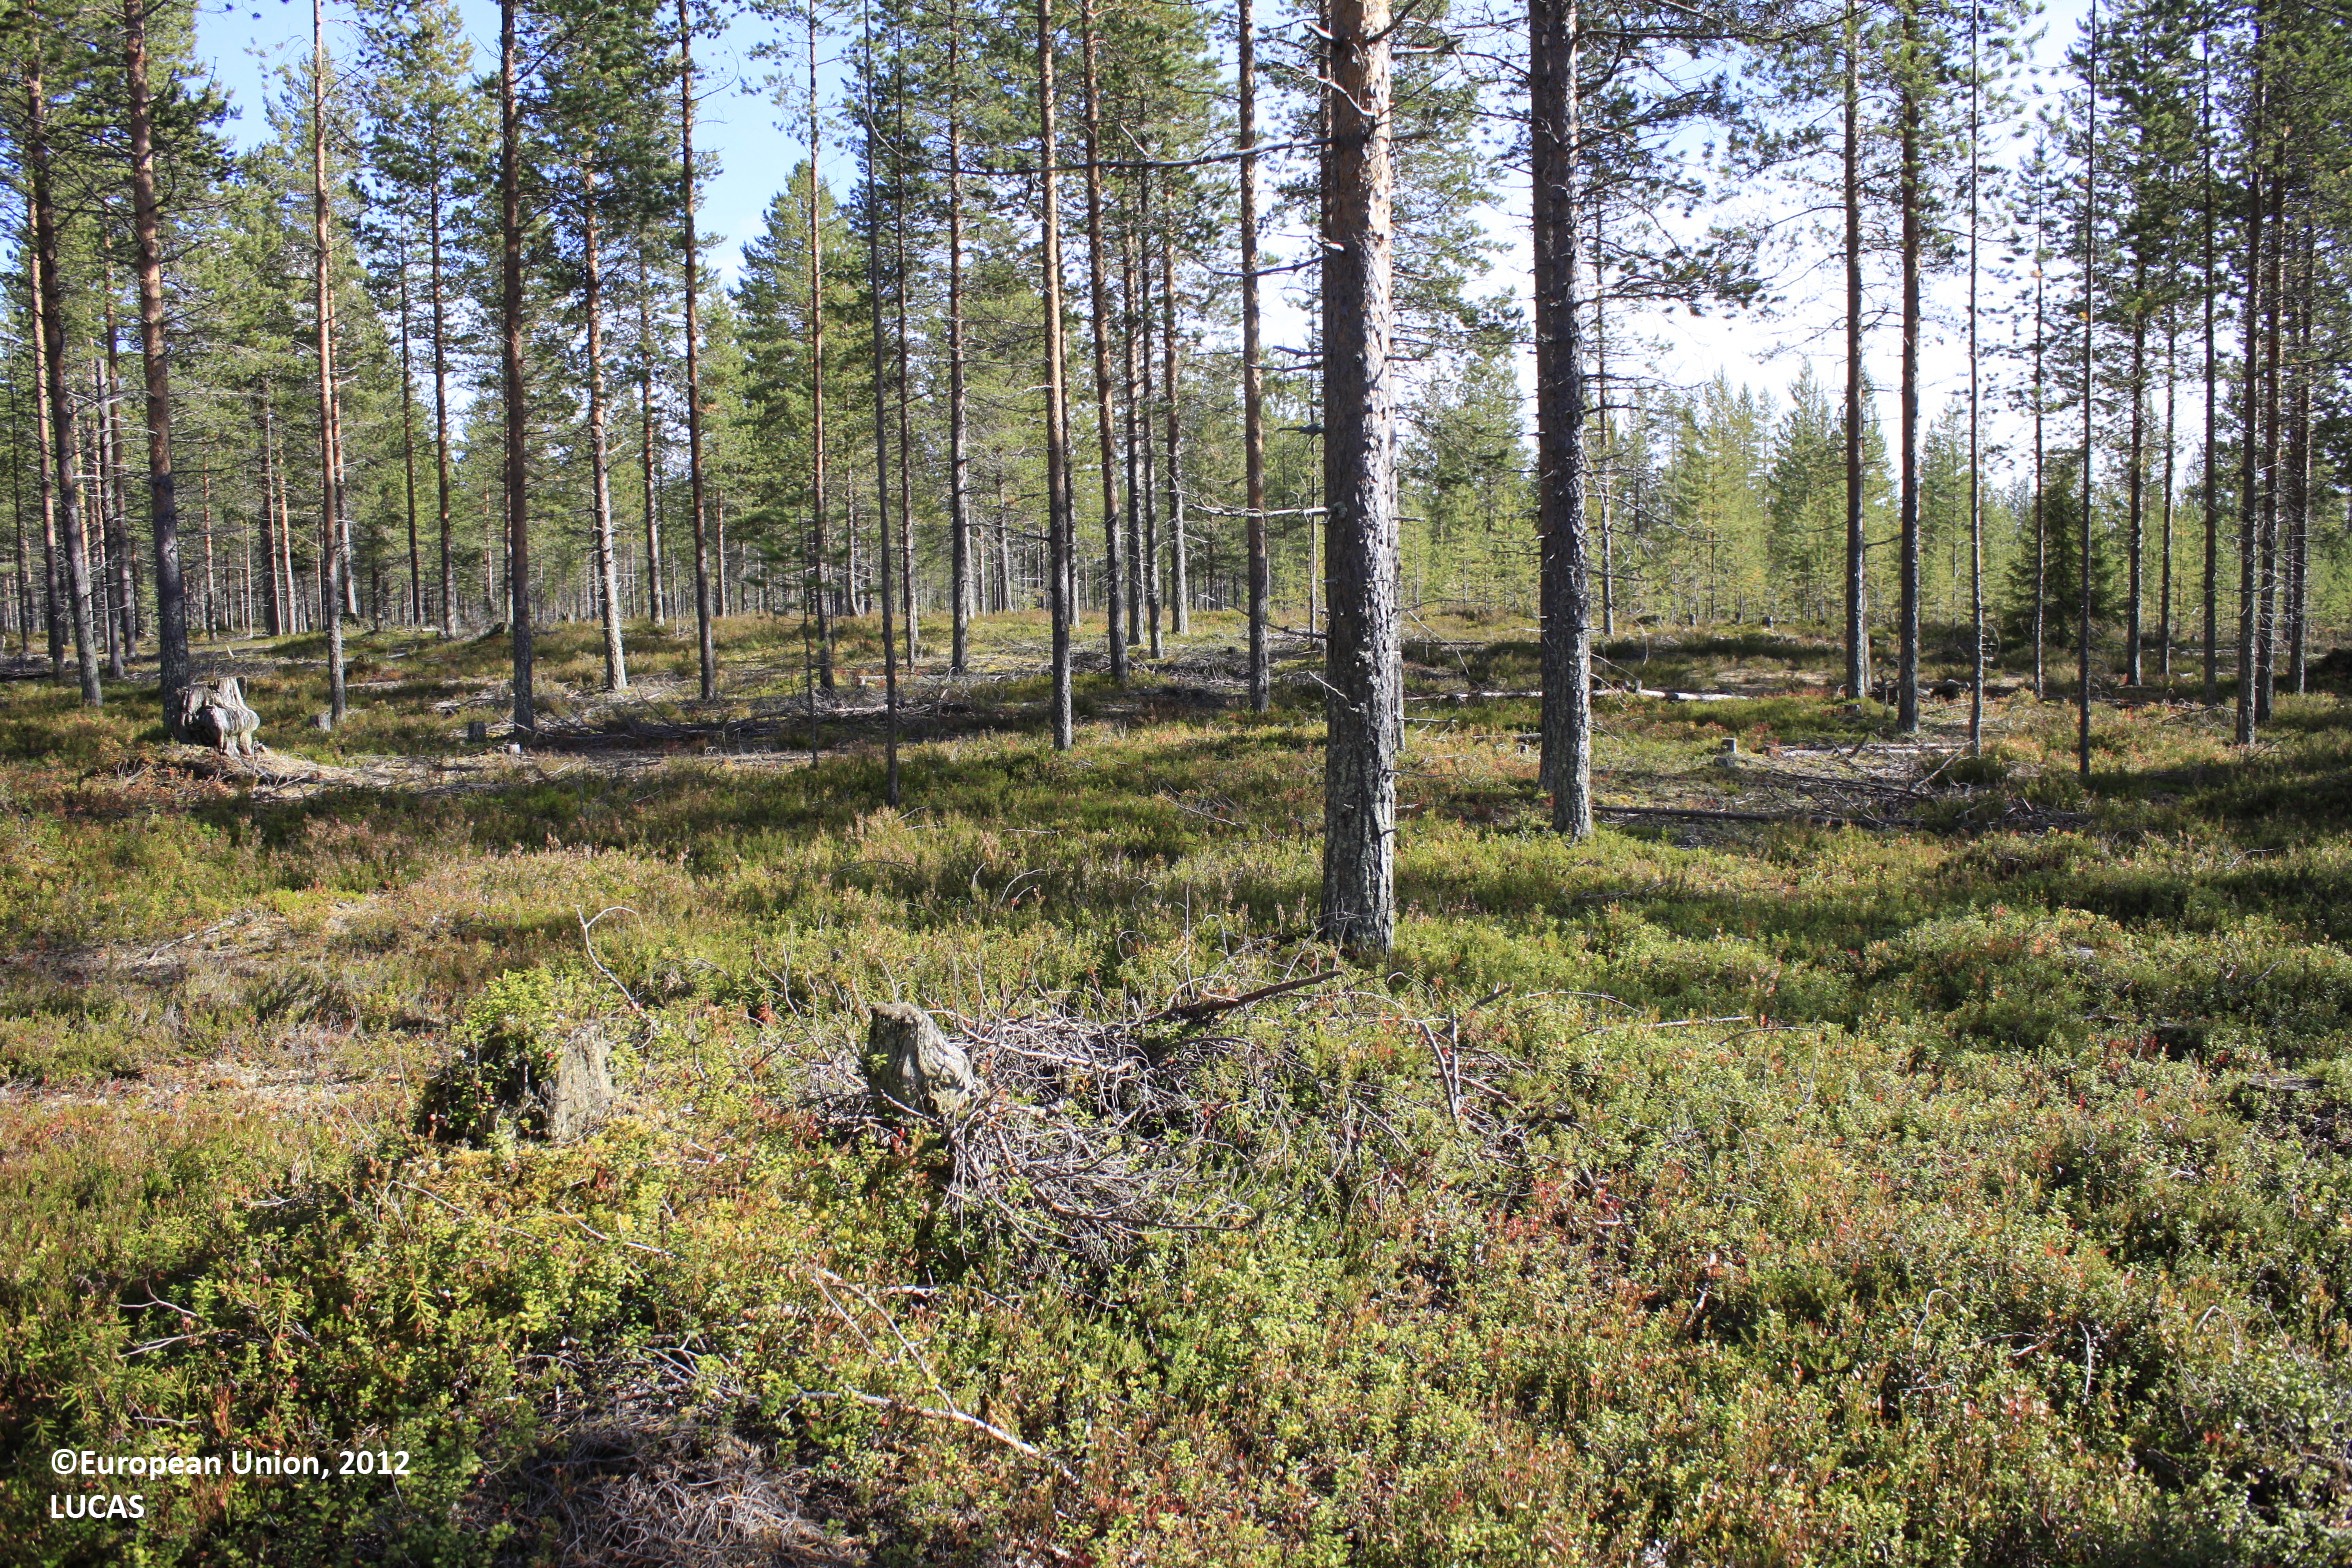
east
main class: Woodland
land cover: Pine dominated coniferous woodland
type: boreal forest
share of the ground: < 10 %
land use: Forestry
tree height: > 5 m
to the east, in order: Pine dominated coniferous woodland; Ditches and canals; Pine dominated coniferous woodland
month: September
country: FI
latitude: 65.5018
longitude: 26.9497
